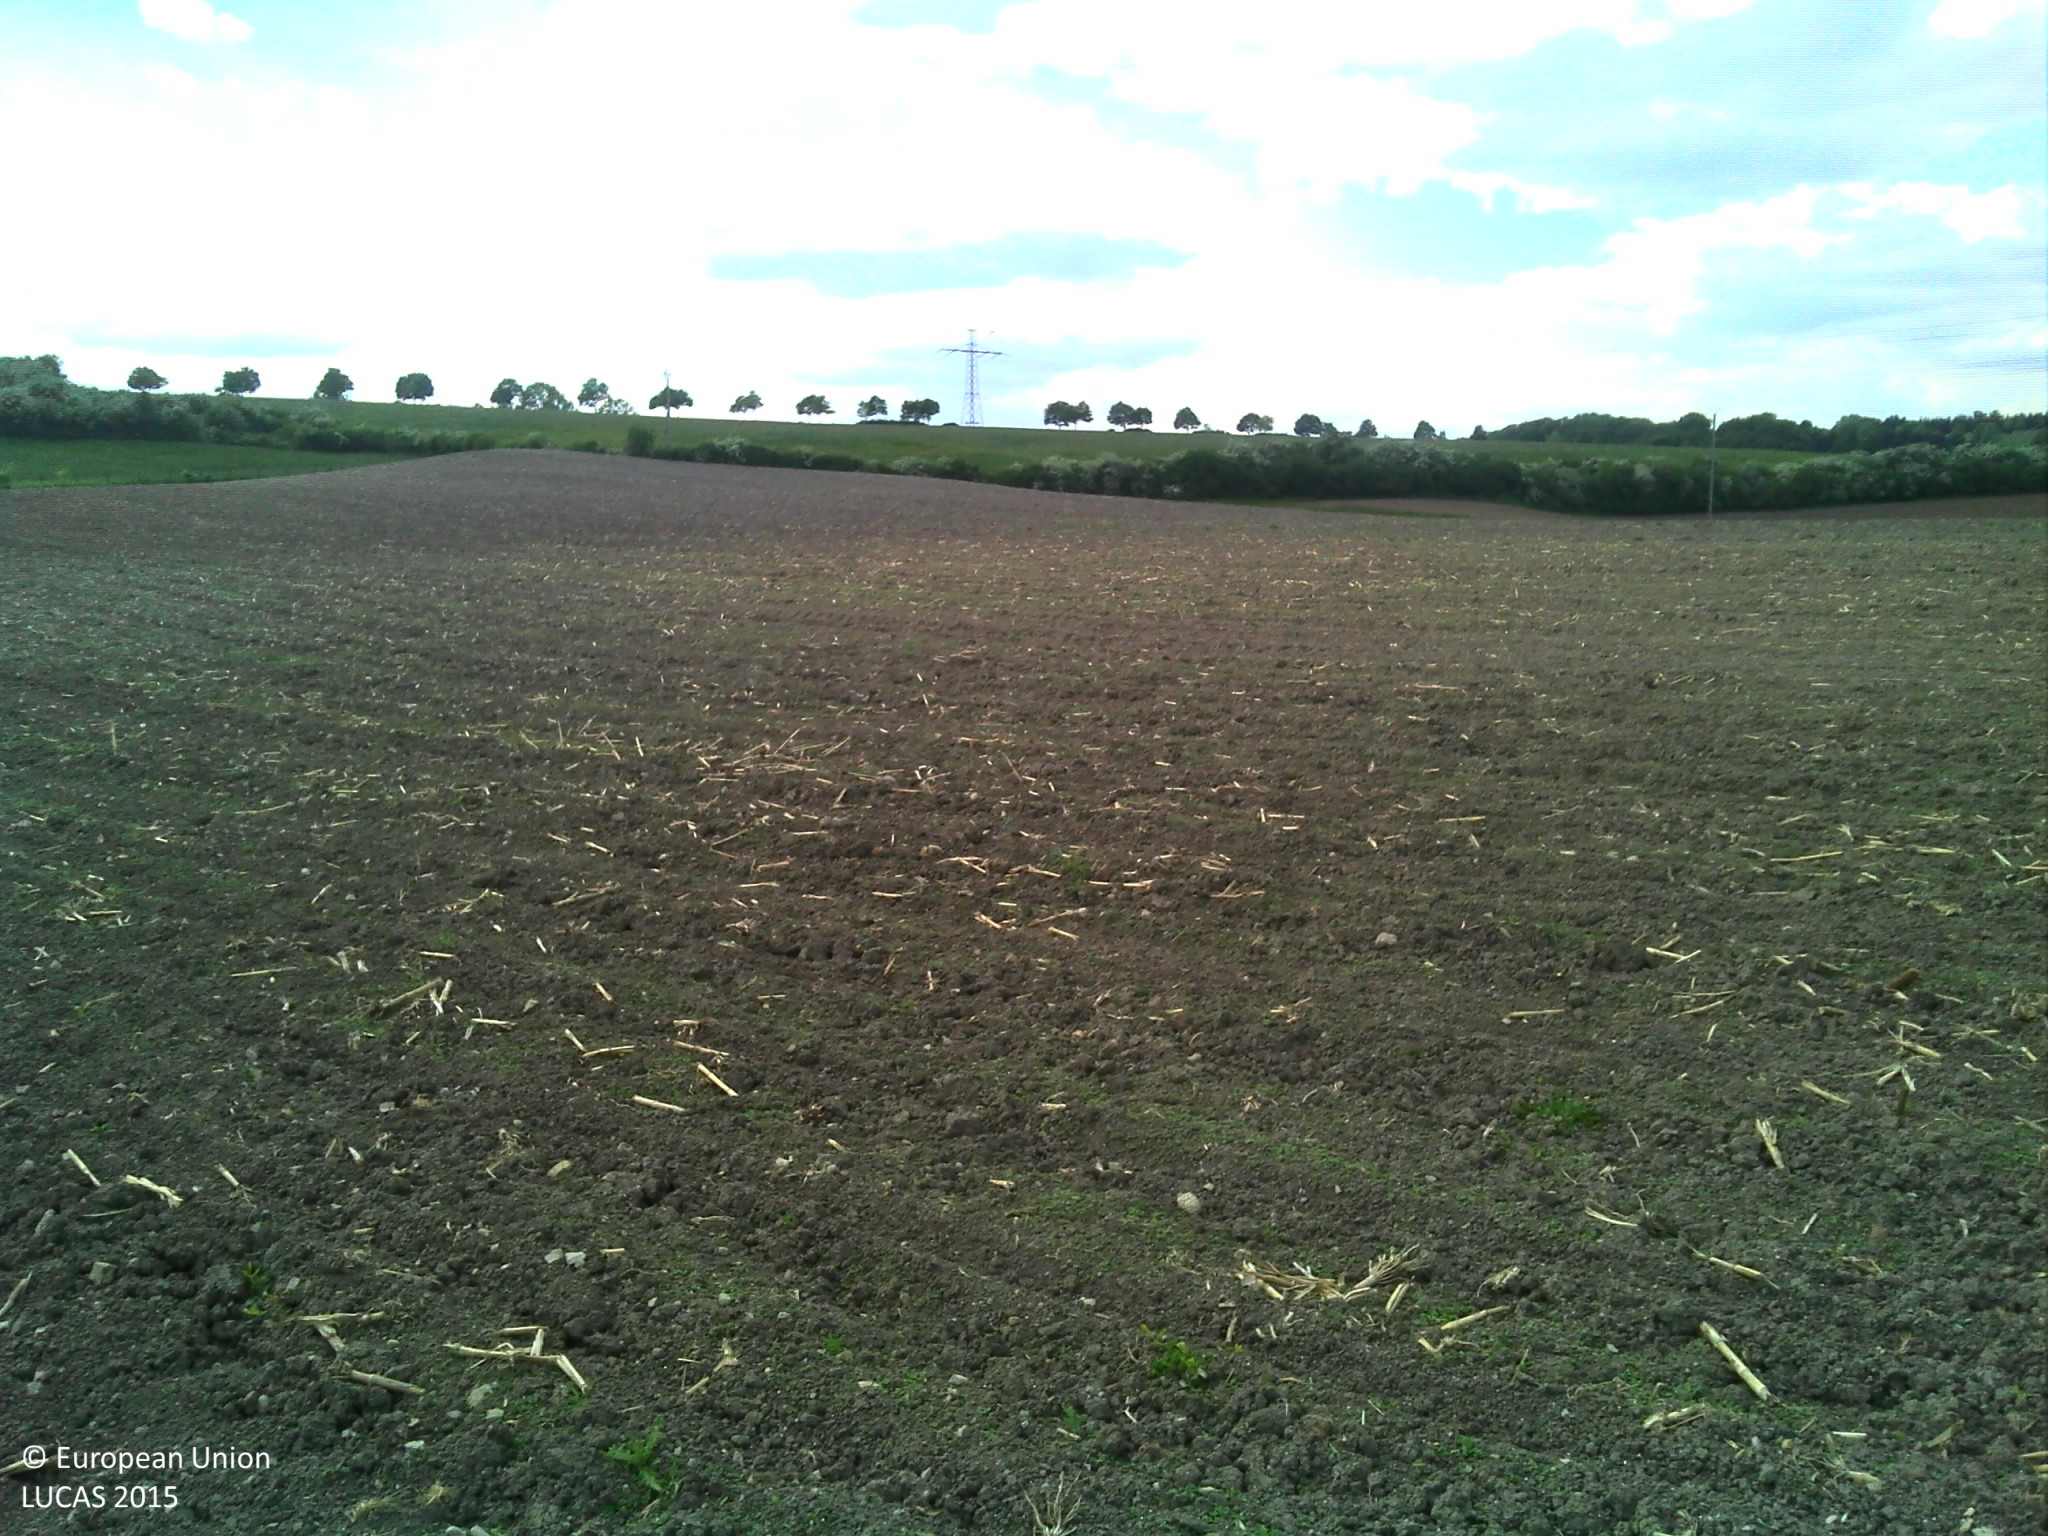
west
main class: Cropland
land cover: Maize
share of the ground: < 10 %
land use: Agriculture (excluding fallow land and kitchen gardens)
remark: Tilled/Sowed
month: May
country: LU
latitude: 49.7271
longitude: 6.2678
